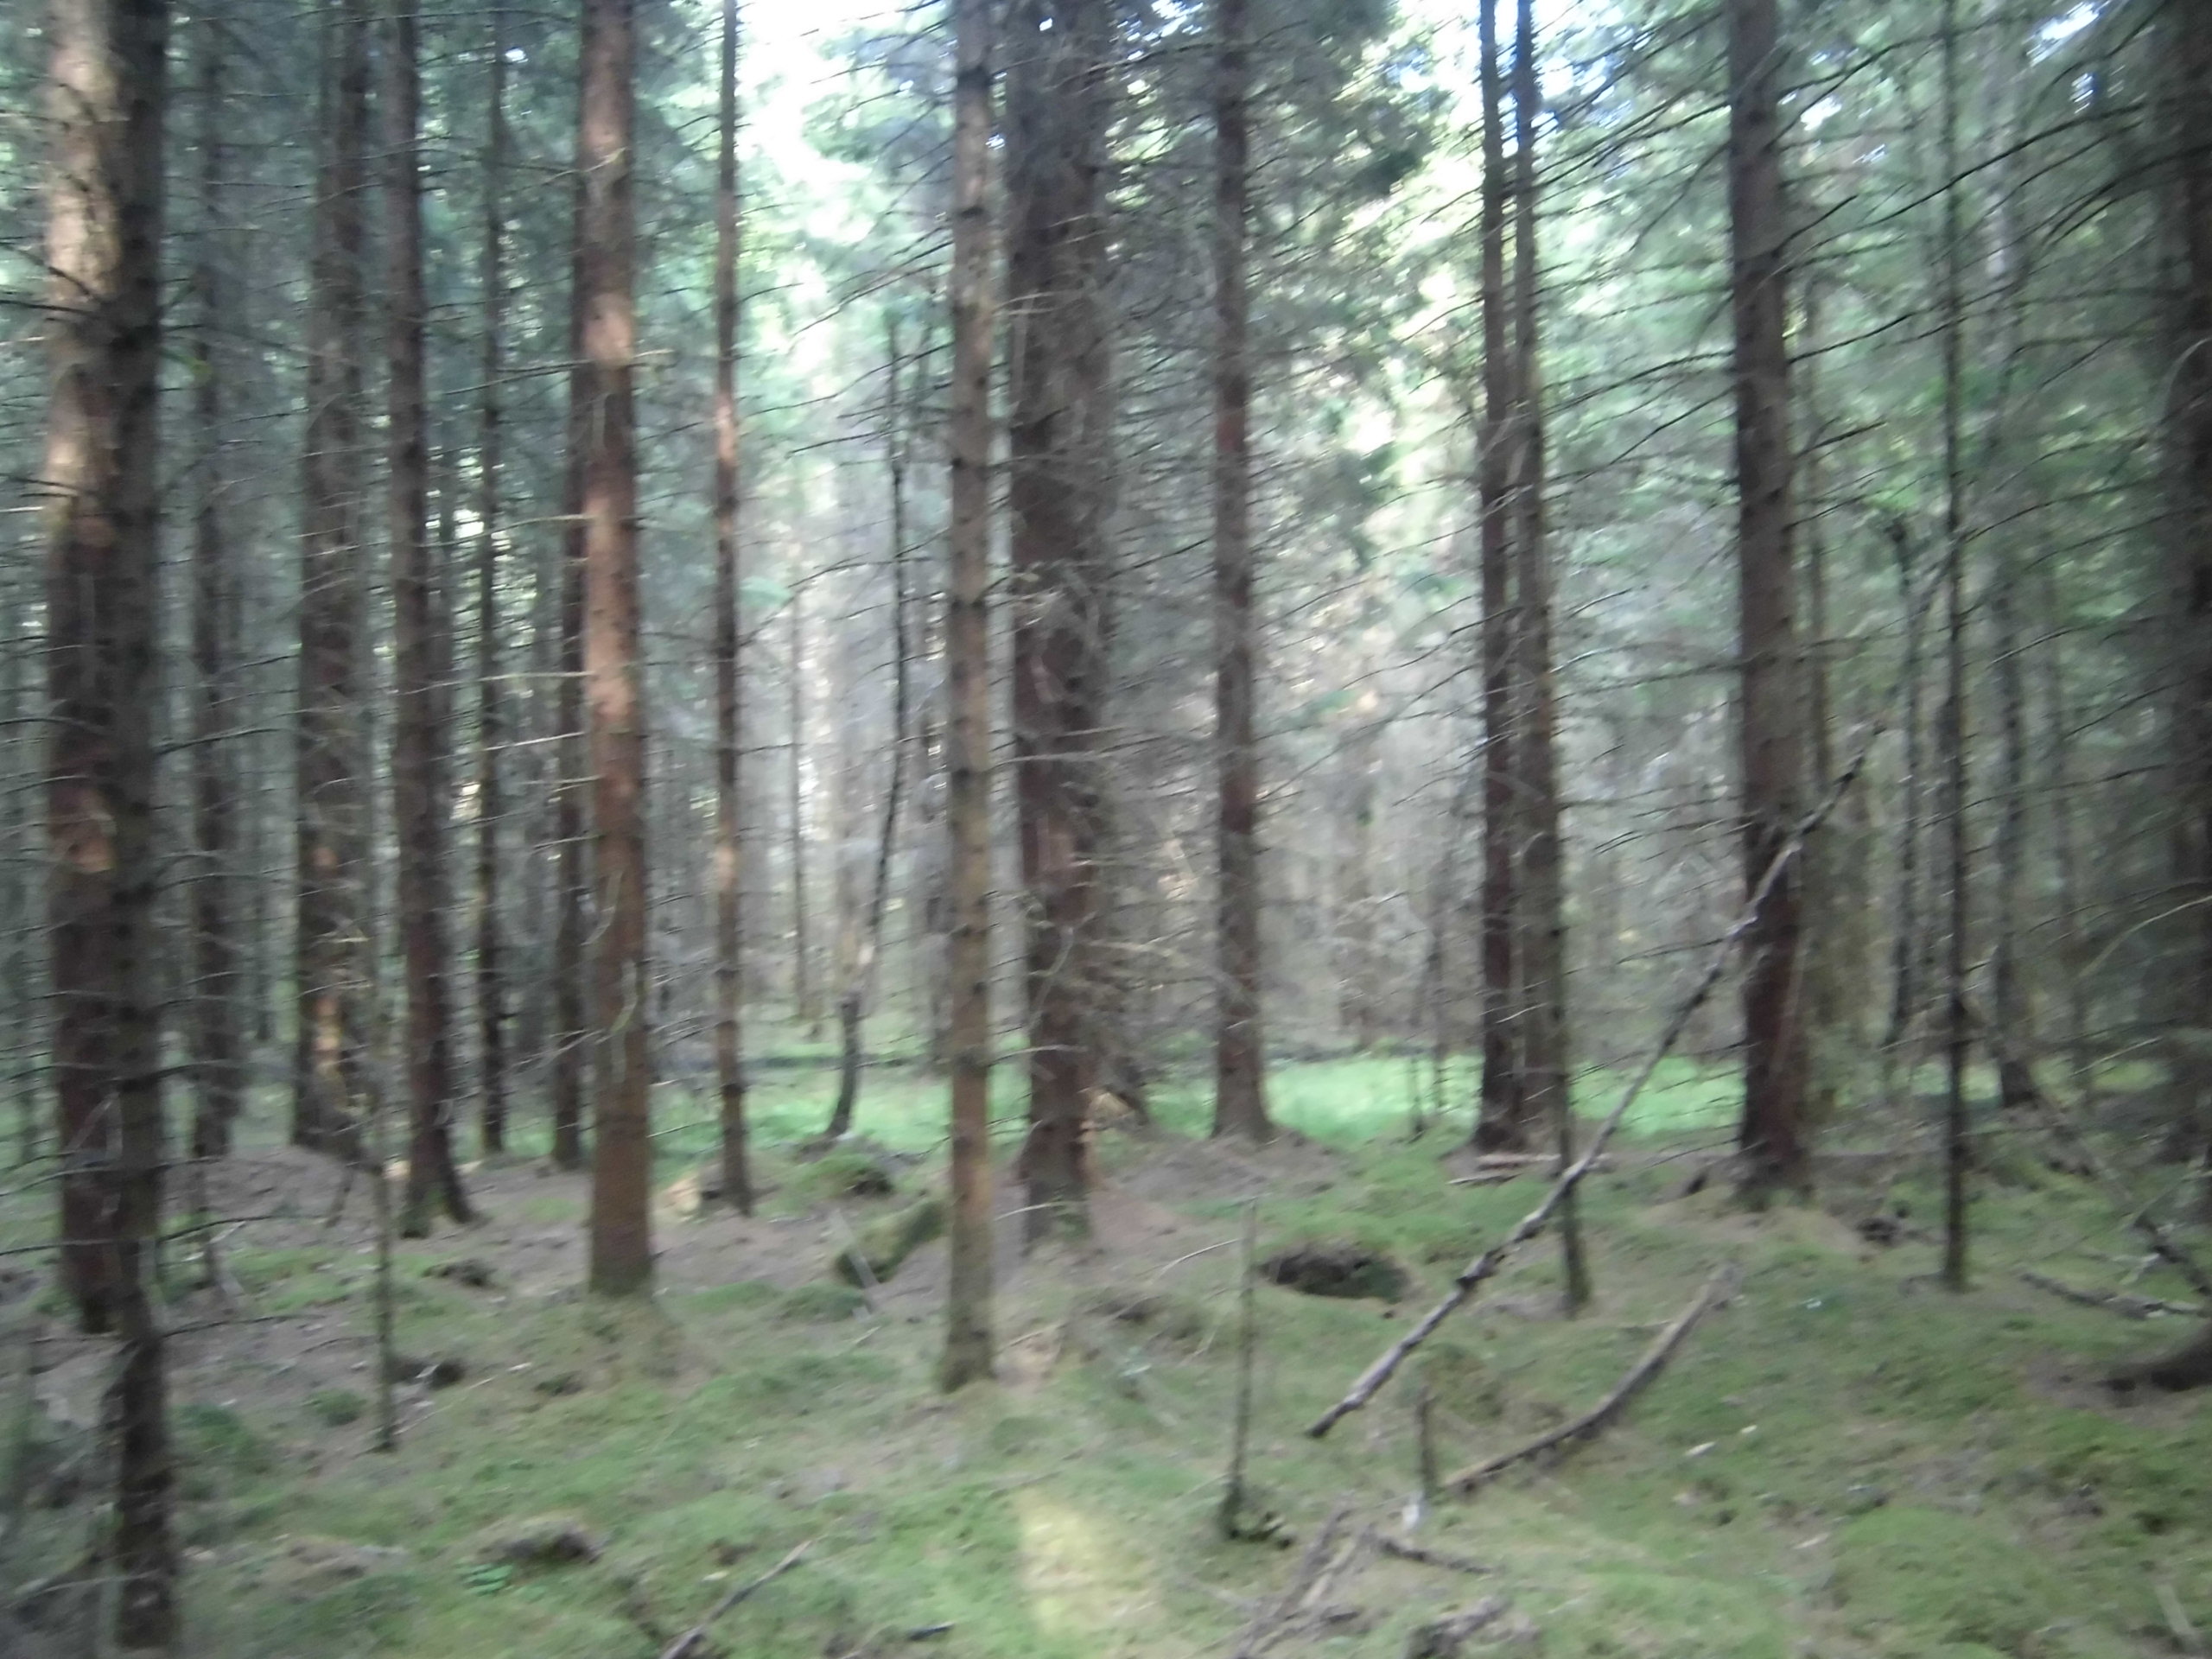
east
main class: Woodland
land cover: Spruce dominated coniferous woodland
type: boreal forest
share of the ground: 50 - 75 %
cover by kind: coniferous forest trees 70 %, lichens and mosses 25 %, herbaceous plants 5 %
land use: Forestry
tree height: > 5 m
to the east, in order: Spruce dominated coniferous woodland; Ditches and canals; Spruce dominated coniferous woodland; Ditches and canals; Spruce dominated coniferous woodland; Spruce dominated mixed woodland; Spruce dominated coniferous woodland; Dry stone walls; Spruce dominated coniferous woodland; Fences; Spruce dominated coniferous woodland; Fences; Spruce dominated coniferous woodland; Tracks; Spruce dominated coniferous woodland
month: July
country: SE
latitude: 57.1711
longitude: 14.5114
